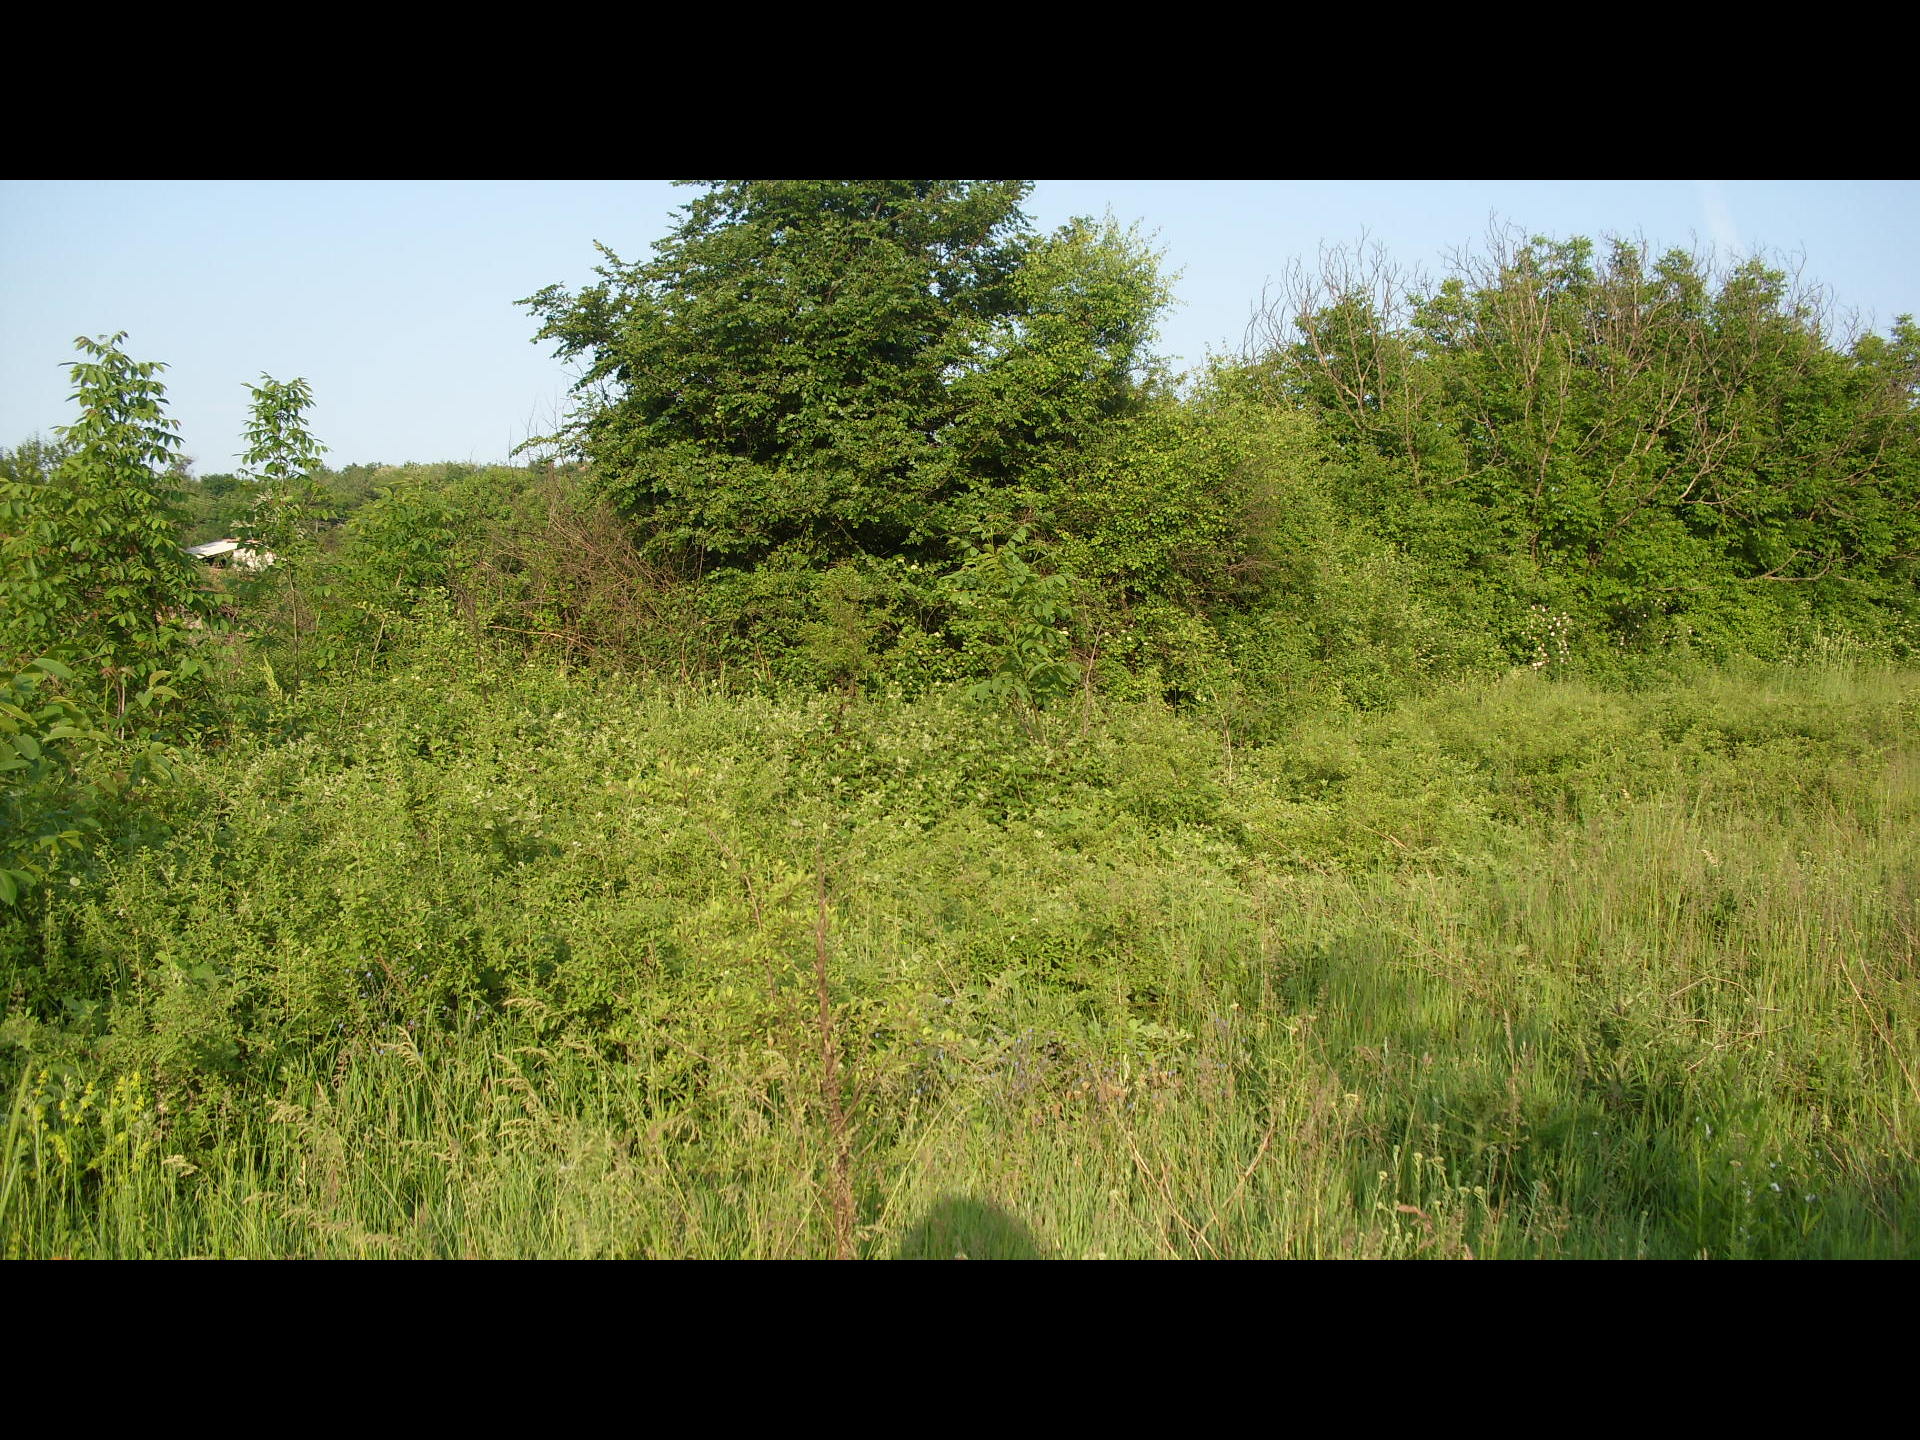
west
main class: Grassland
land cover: Grassland with sparse tree/shrub cover
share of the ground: > 75 %
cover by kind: herbaceous plants 90 %, broadleaved forest trees 5 %, shrubs 5 %
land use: Semi-natural and natural areas not in use
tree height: < 5 m
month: May
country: BG
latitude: 43.4275
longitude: 23.2201
